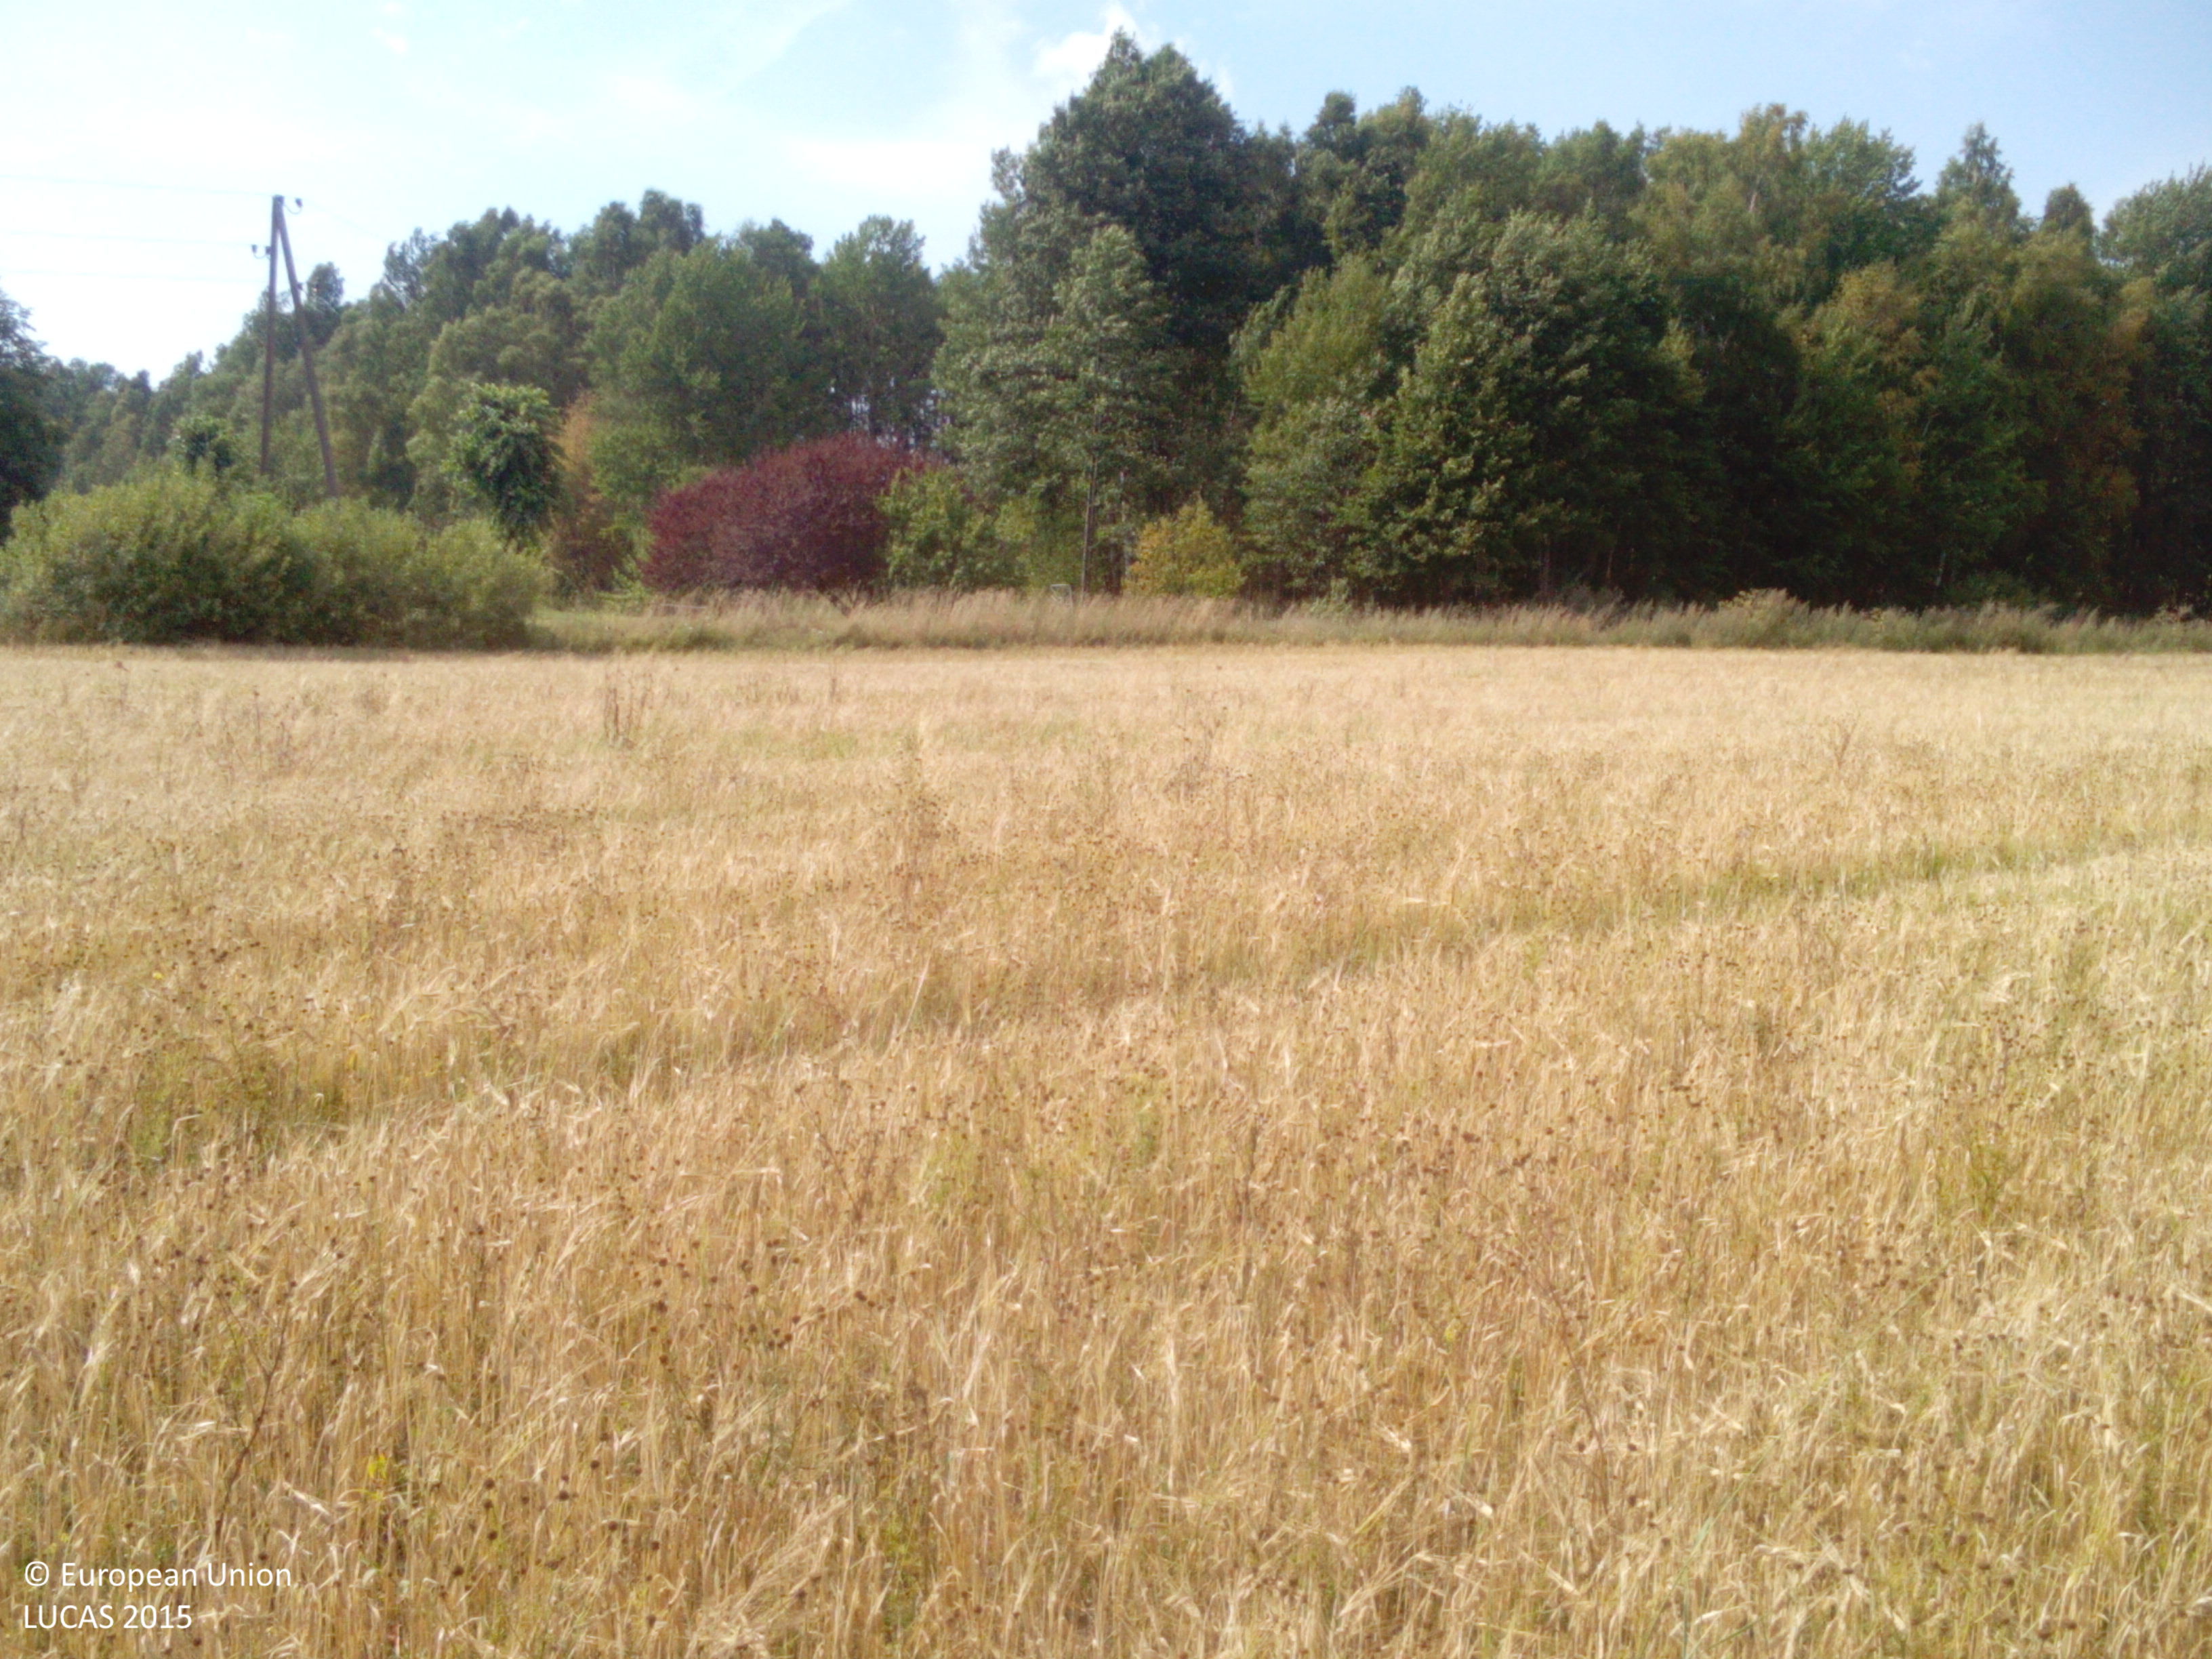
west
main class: Cropland
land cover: Barley
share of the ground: > 75 %
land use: Agriculture (excluding fallow land and kitchen gardens)
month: August
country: LV
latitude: 56.2912
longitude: 21.0396
